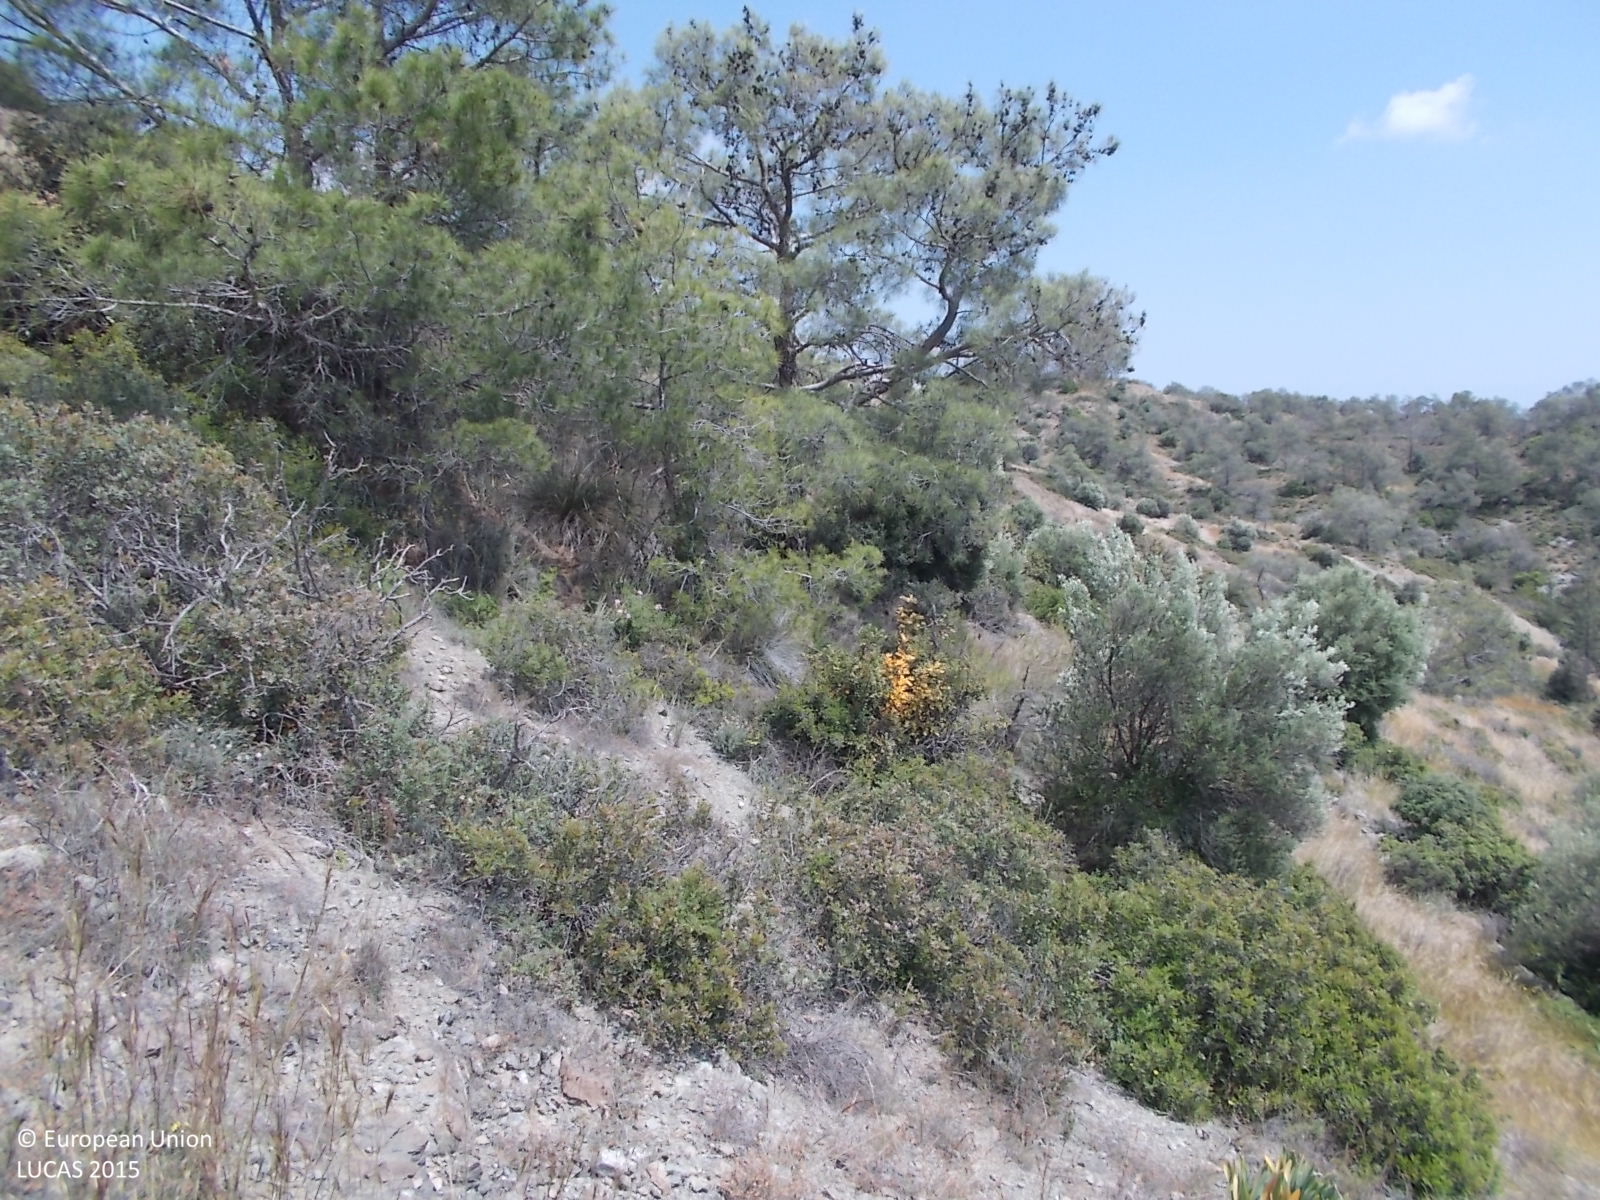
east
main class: Shrubland
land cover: Shrubland with sparse tree cover
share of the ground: 50 - 75 %
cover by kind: shrubs 60 %, unconsolidated bare surface 35 %, broadleaved forest trees 5 %
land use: Semi-natural and natural areas not in use
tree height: > 5 m
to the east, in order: Shrubland with sparse tree cover; Shrubland without tree cover; Dry stone walls; Shrubland with sparse tree cover; Shrubland without tree cover; Shrubland with sparse tree cover; Grassland without tree/shrub cover
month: April
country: CY
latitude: 34.7620
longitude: 33.1246
